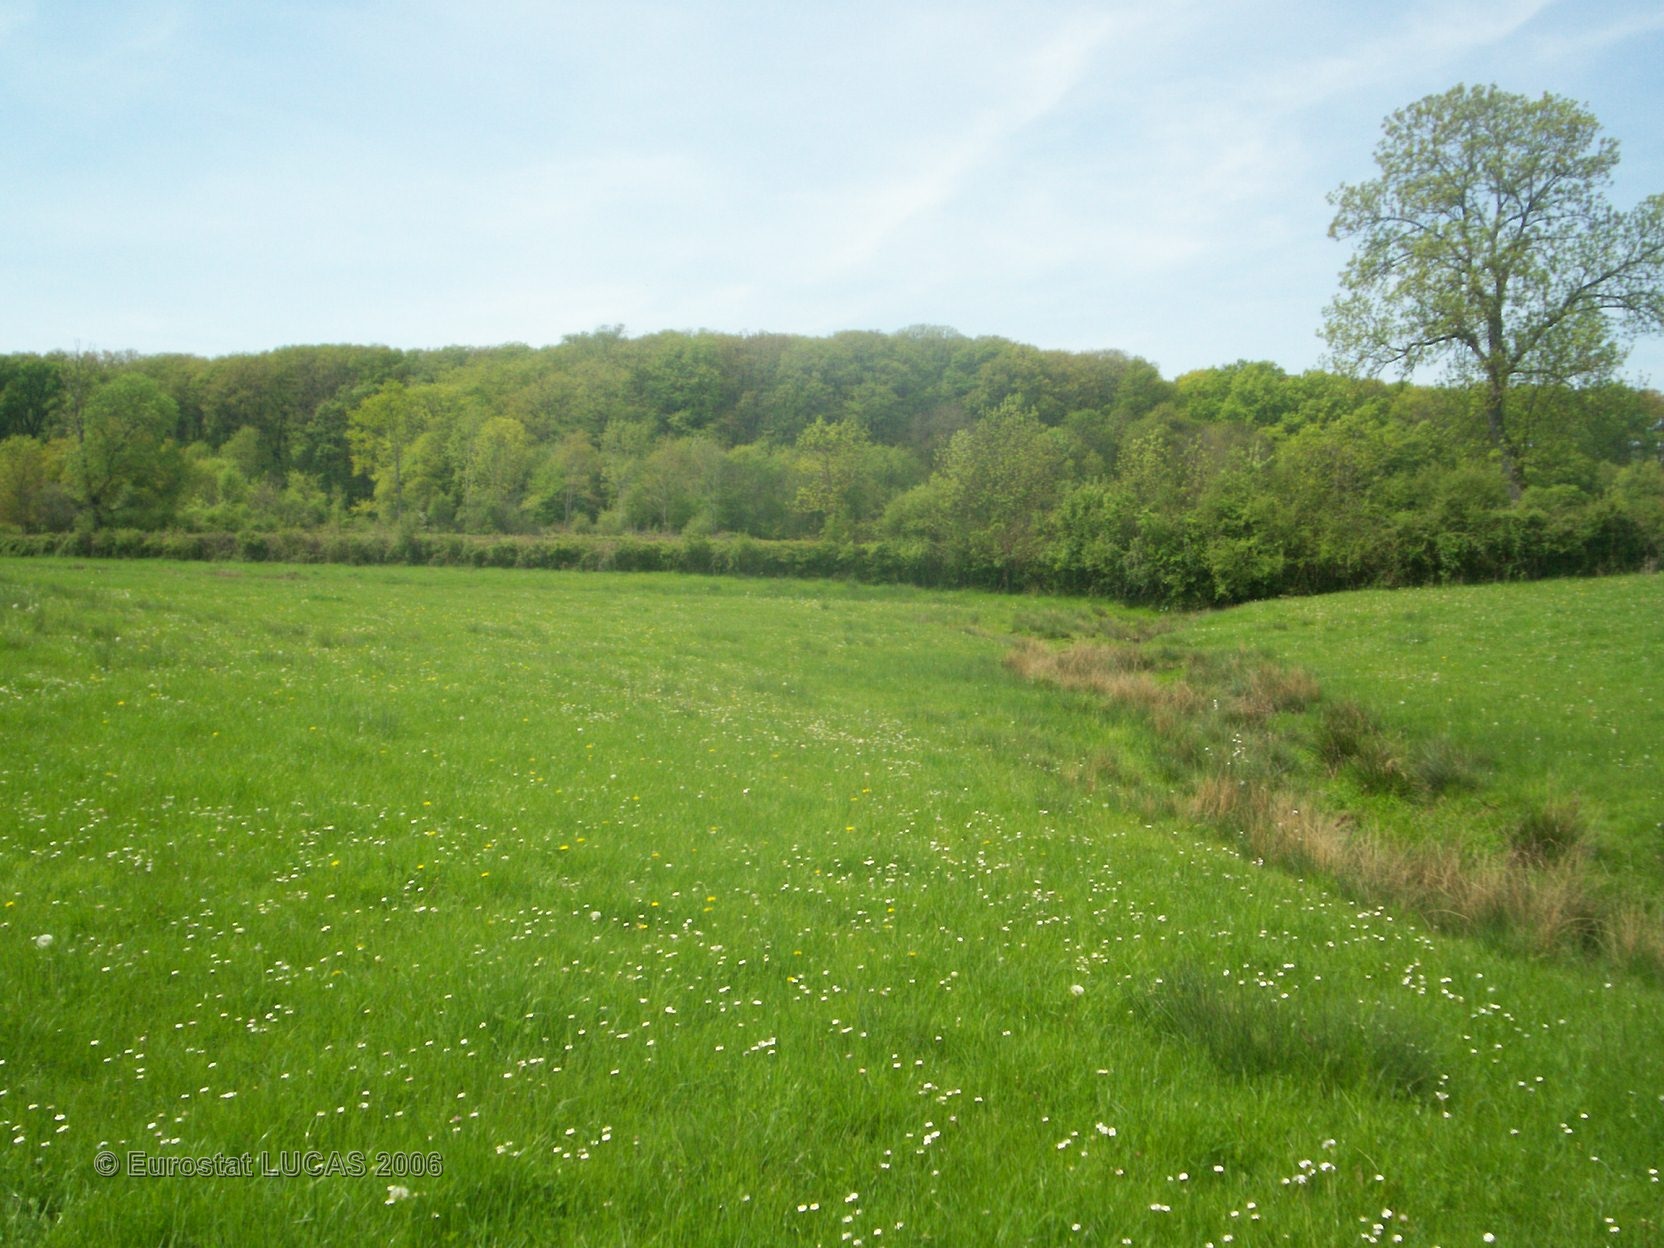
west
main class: Grassland
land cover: Grassland with sparse tree/shrub cover
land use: Agriculture (excluding fallow land and kitchen gardens)
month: May
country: FR
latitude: 46.5276
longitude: 3.1271
